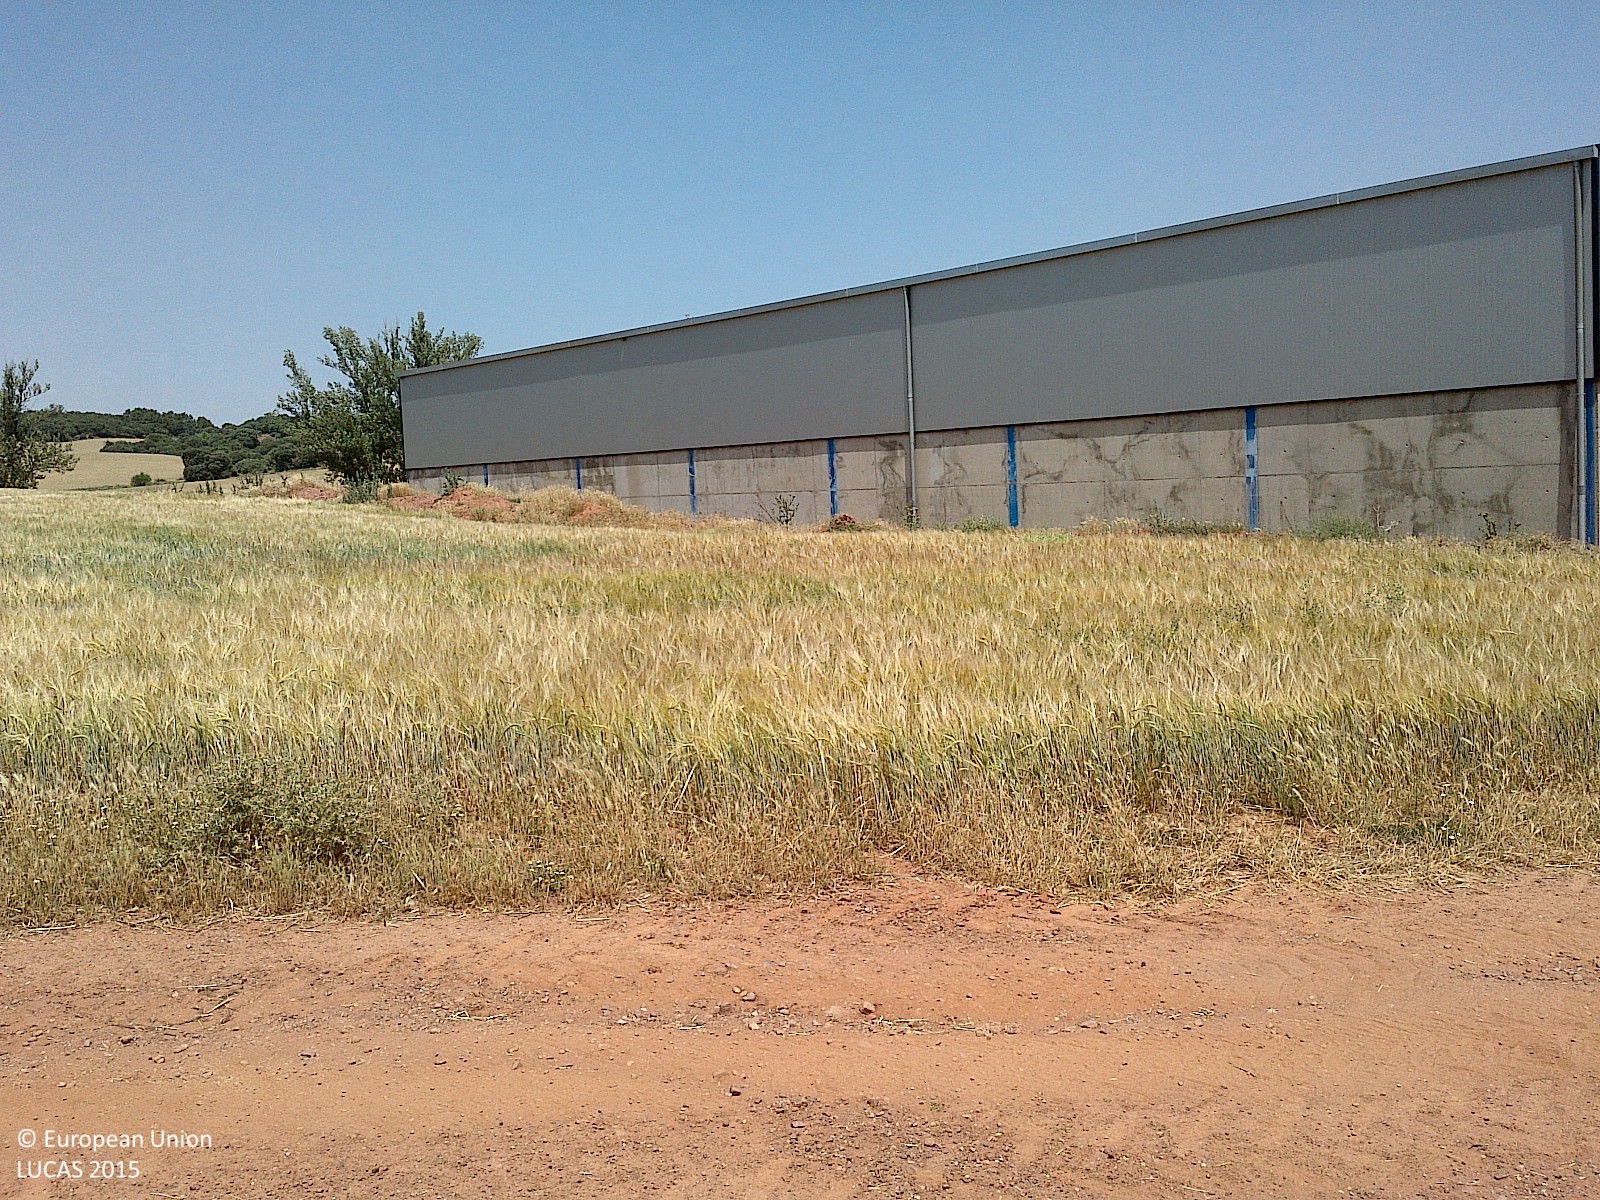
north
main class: Grassland
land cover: Spontaneously vegetated surfaces
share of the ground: 50 - 75 %
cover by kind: herbaceous plants 55 %, unconsolidated bare surface 45 %
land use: Fallow land
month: July
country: ES
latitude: 41.5687
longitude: -2.0354
